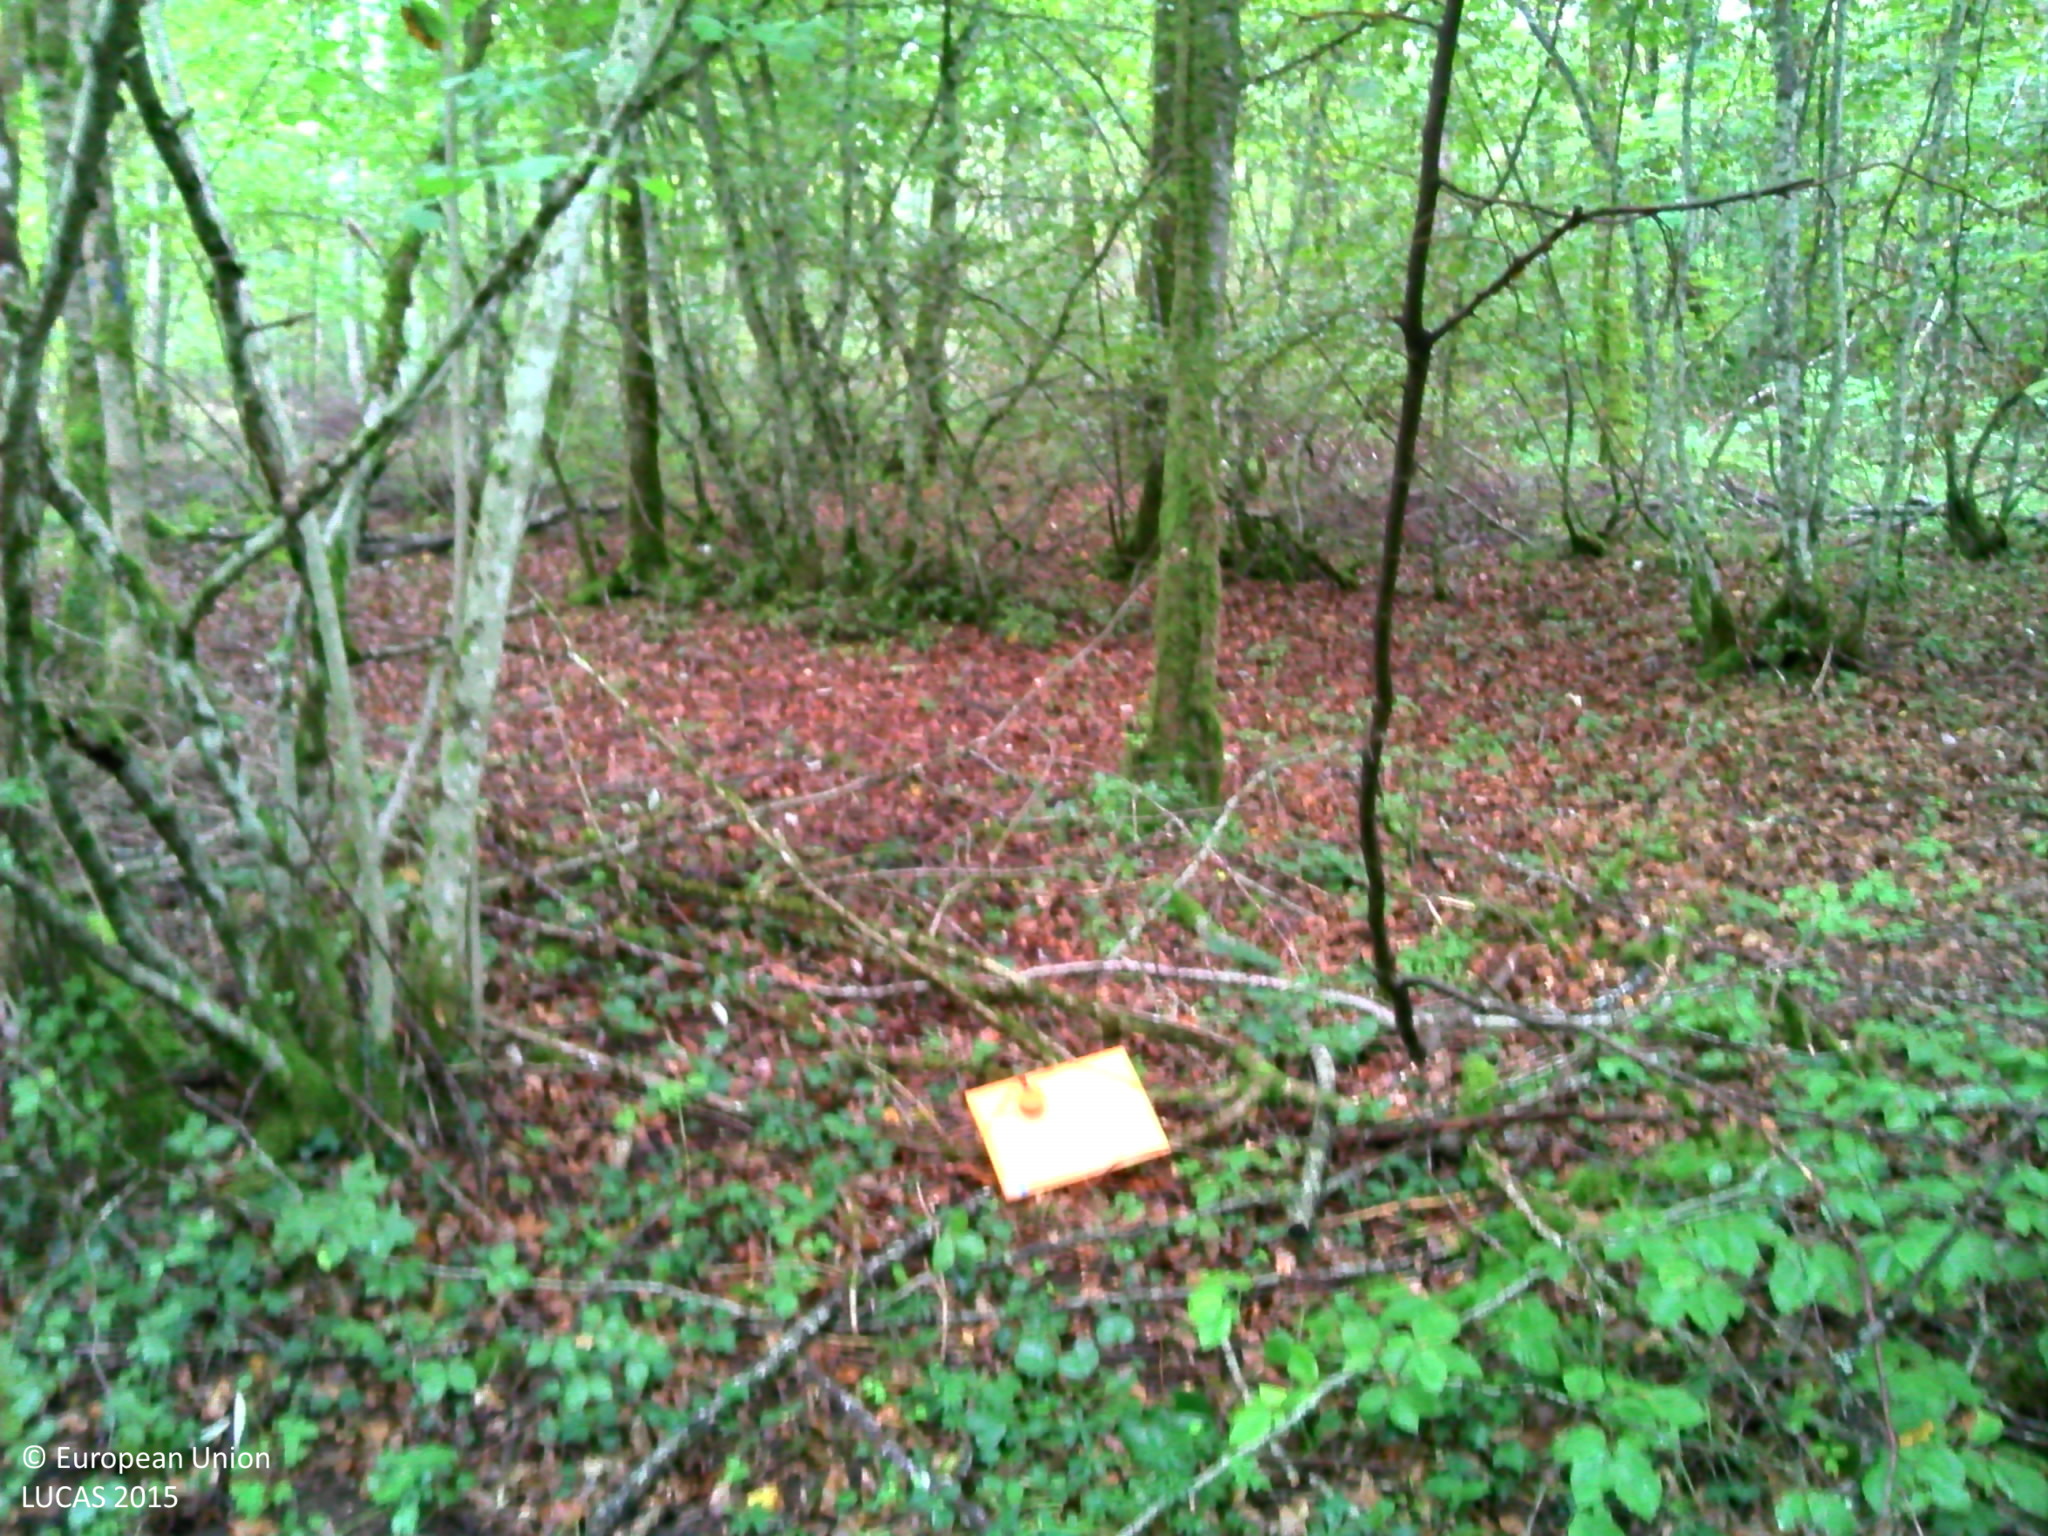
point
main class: Woodland
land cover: Broadleaved woodland
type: mesophytic deciduous forest
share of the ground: > 75 %
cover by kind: broadleaved forest trees 80 %, herbaceous plants 15 %, shrubs 5 %
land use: Forestry
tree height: > 5 m
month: September
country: FR
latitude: 47.1266
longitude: 4.7935
